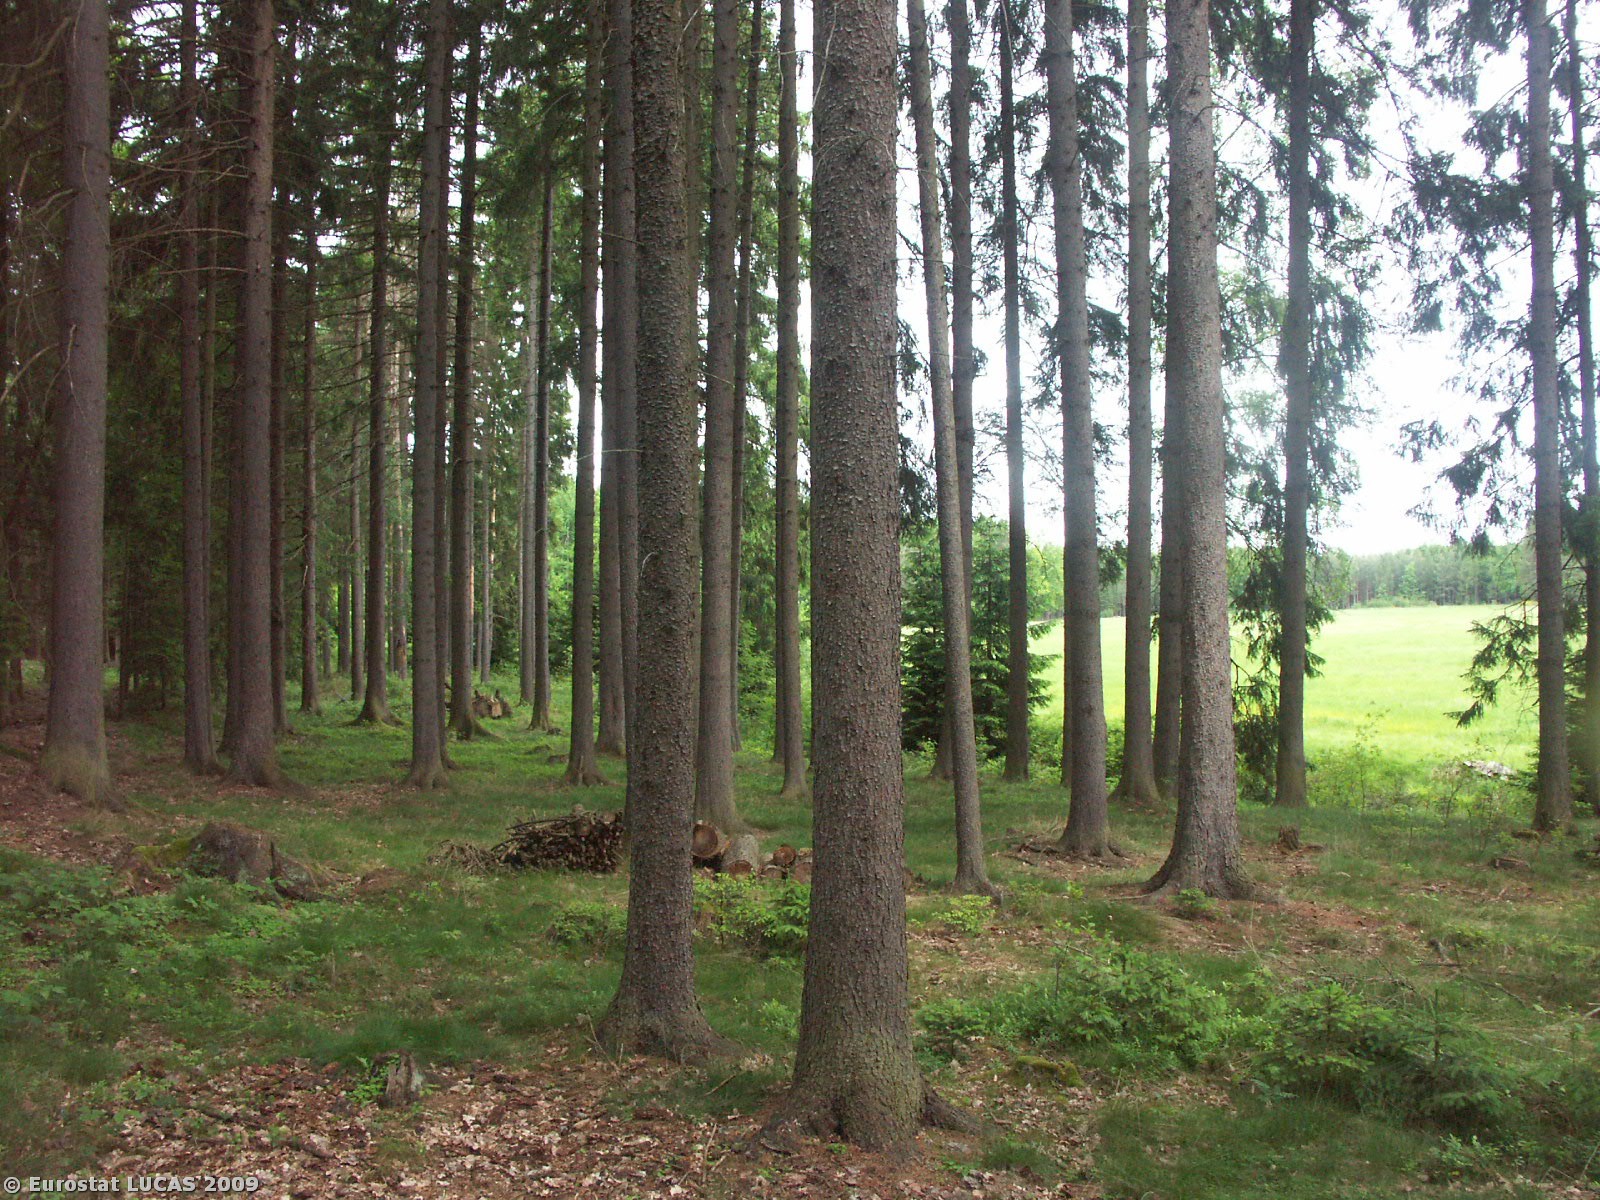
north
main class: Woodland
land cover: Mixed woodland
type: hemiboreal forest and nemoral coniferous forest and mixed broadleaved-coniferous forest
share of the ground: > 75 %
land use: Forestry
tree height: > 5 m
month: May
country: CZ
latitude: 48.8644
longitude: 14.6497
